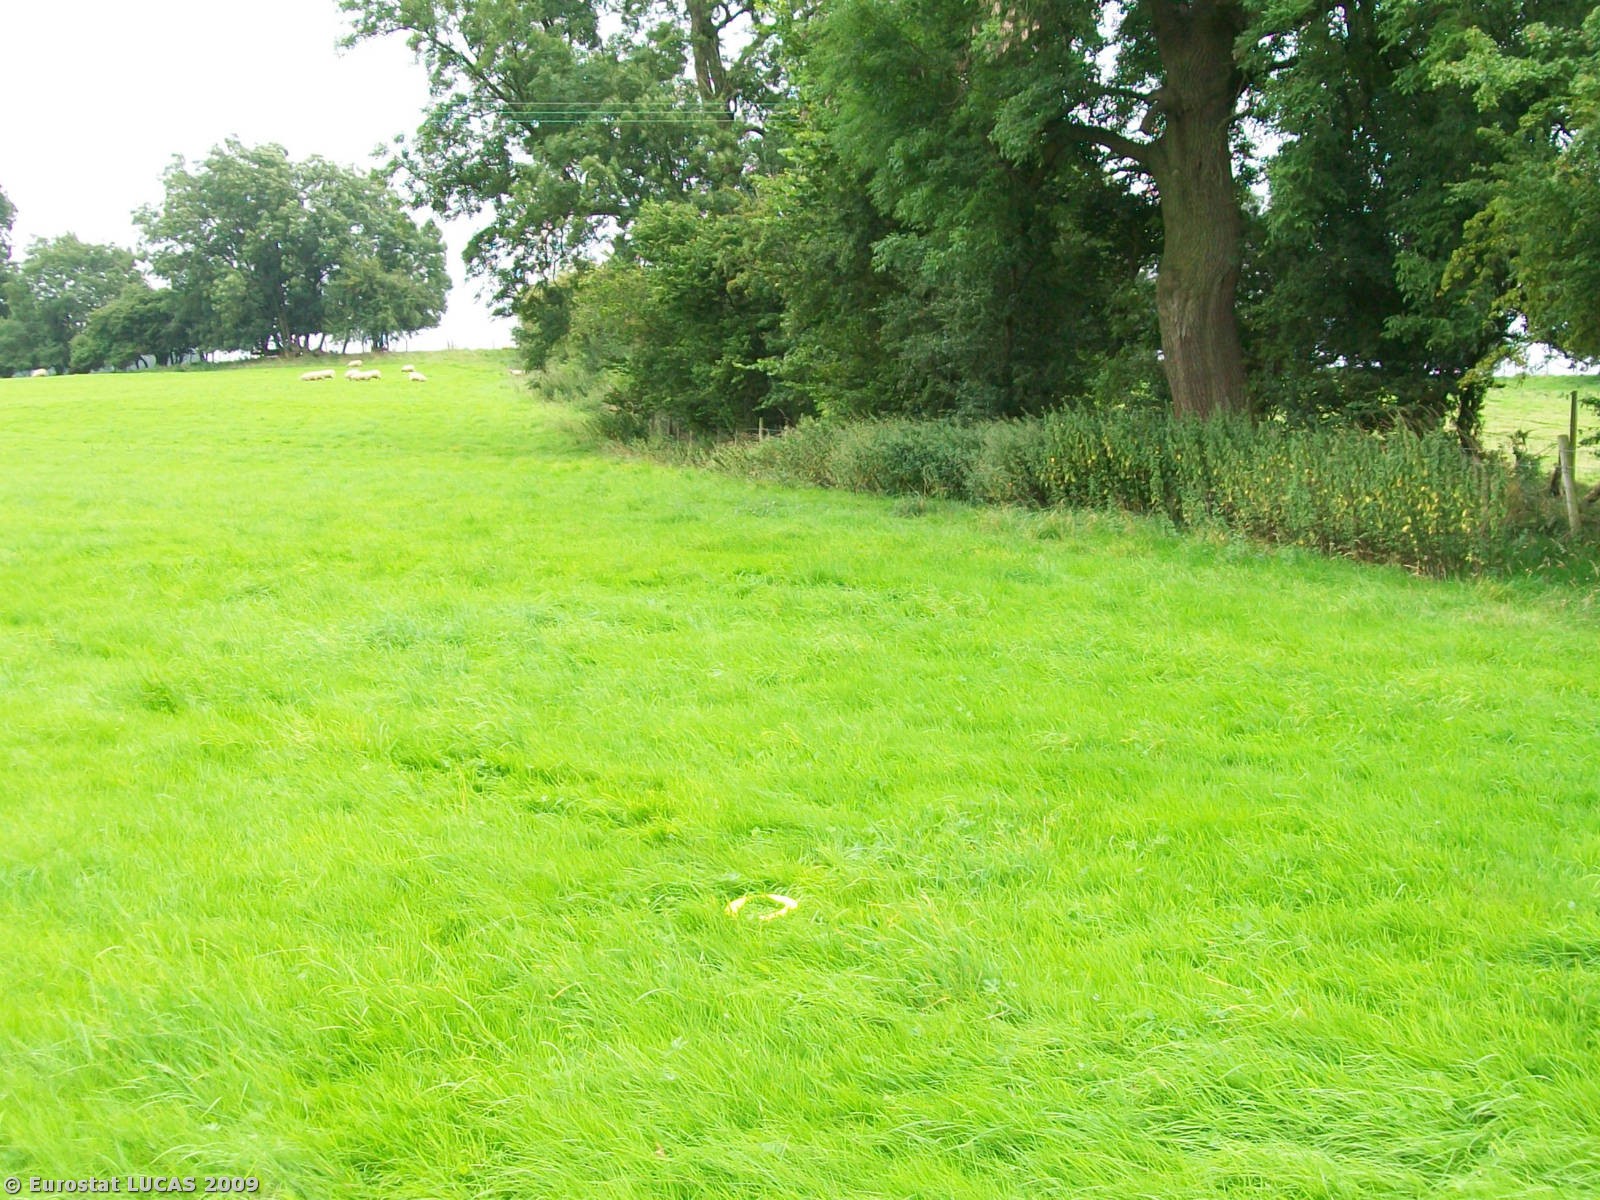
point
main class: Grassland
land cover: Grassland without tree/shrub cover
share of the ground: > 75 %
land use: Agriculture (excluding fallow land and kitchen gardens)
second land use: Community services
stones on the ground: < 10 %
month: August
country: GB
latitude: 51.6935
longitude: -2.3464
